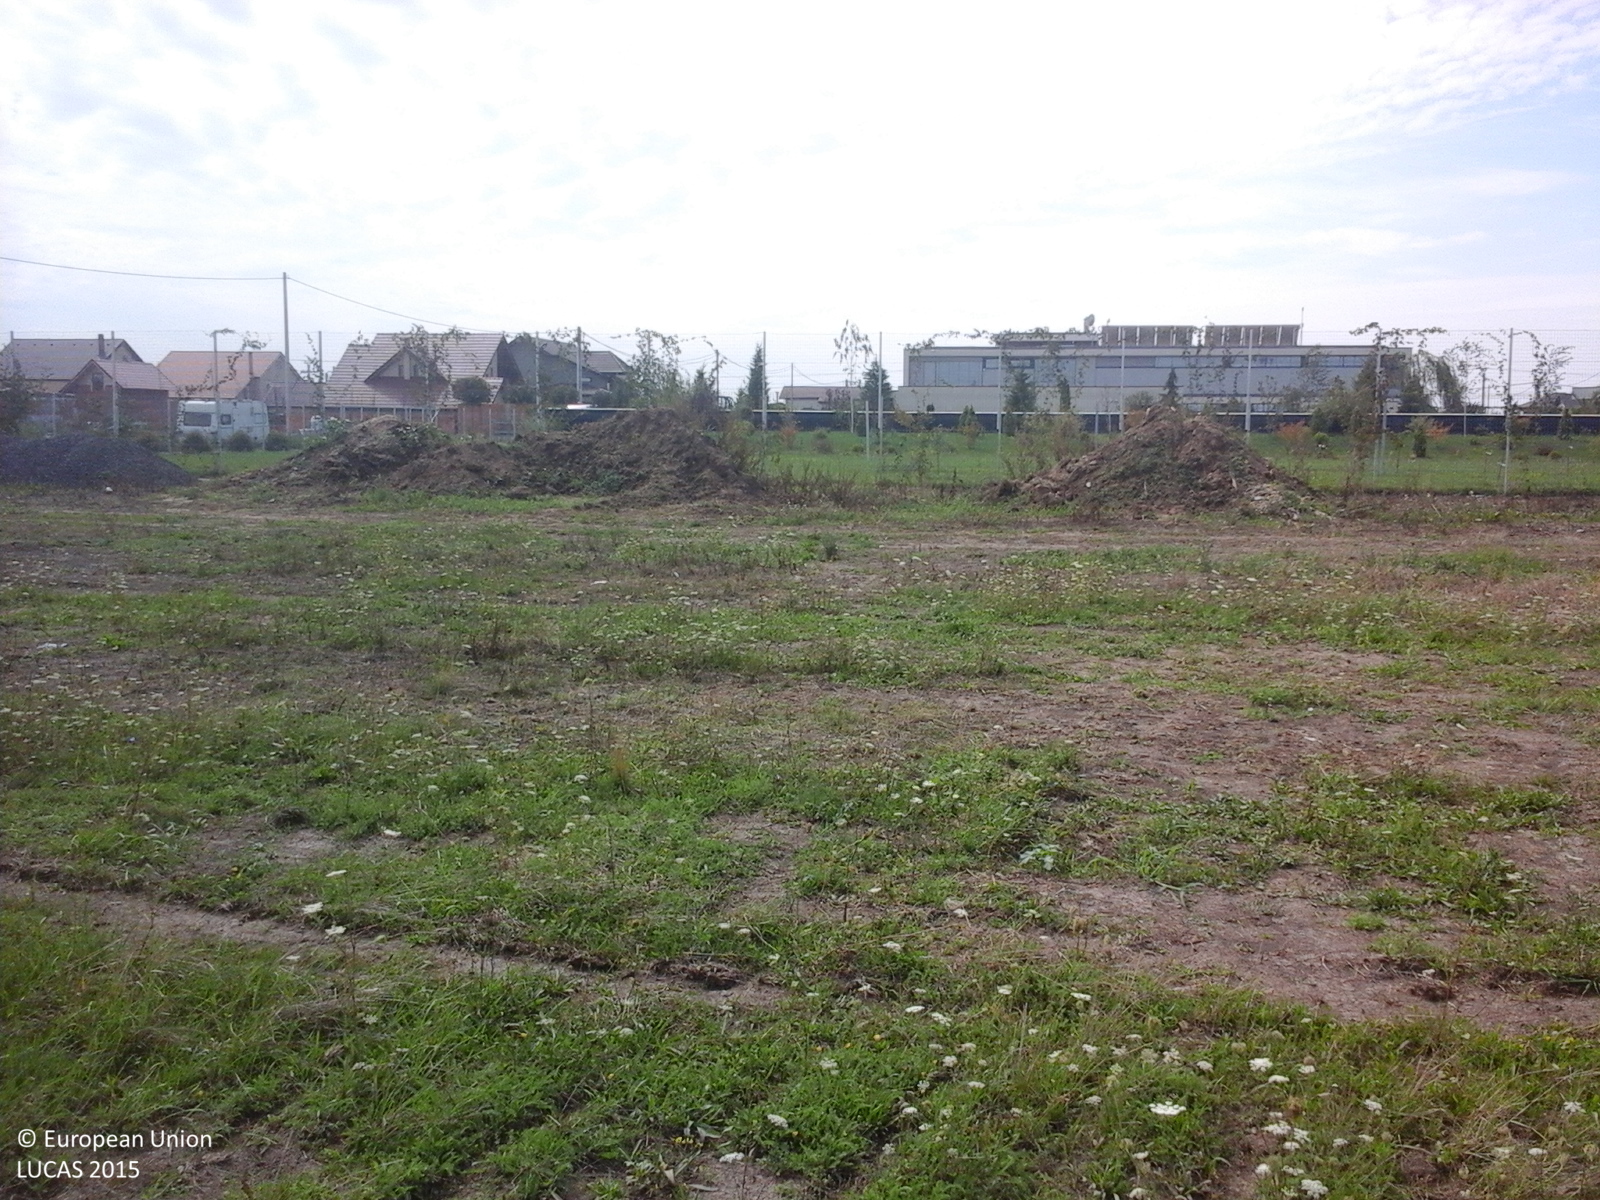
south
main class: Grassland
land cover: Grassland without tree/shrub cover
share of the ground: > 75 %
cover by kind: herbaceous plants 100 %
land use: Agriculture (excluding fallow land and kitchen gardens)
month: August
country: RO
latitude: 46.1765
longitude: 21.3952
